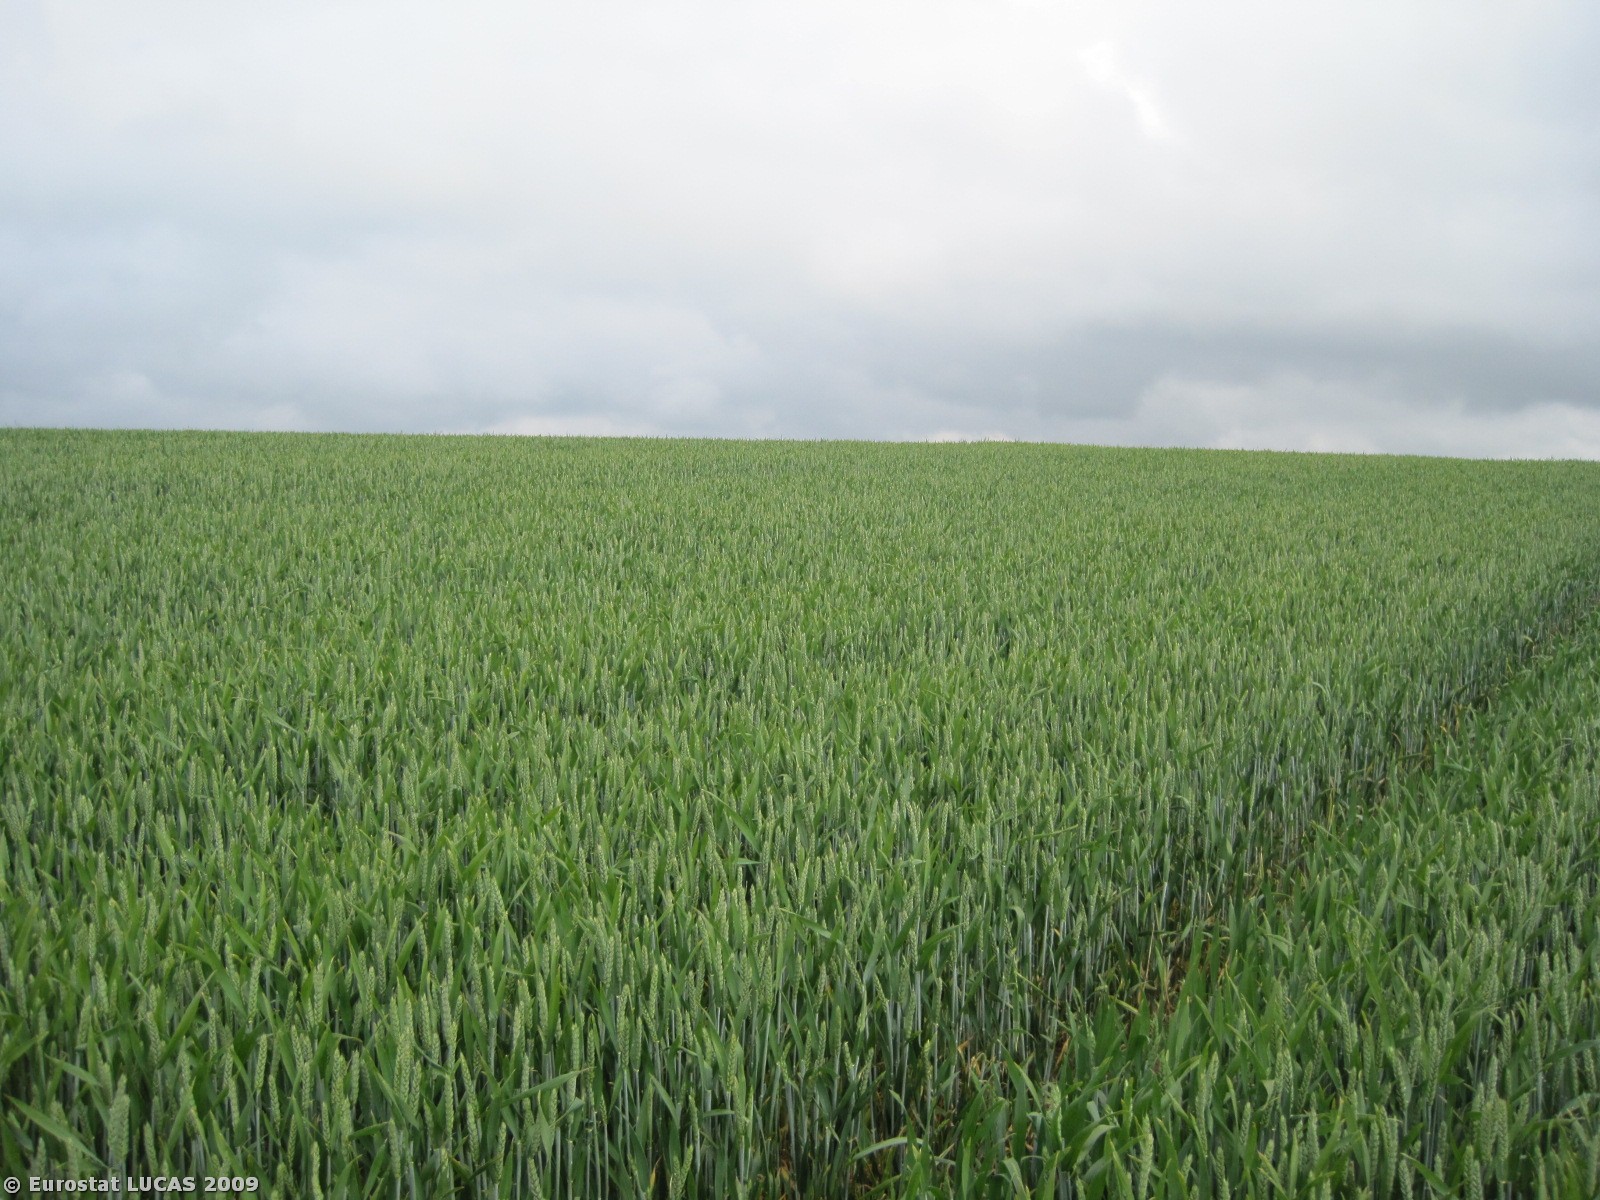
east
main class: Cropland
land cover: Common wheat
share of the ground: > 75 %
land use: Agriculture (excluding fallow land and kitchen gardens)
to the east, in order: Common wheat
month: June
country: DK
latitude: 57.3561
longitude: 10.2489
